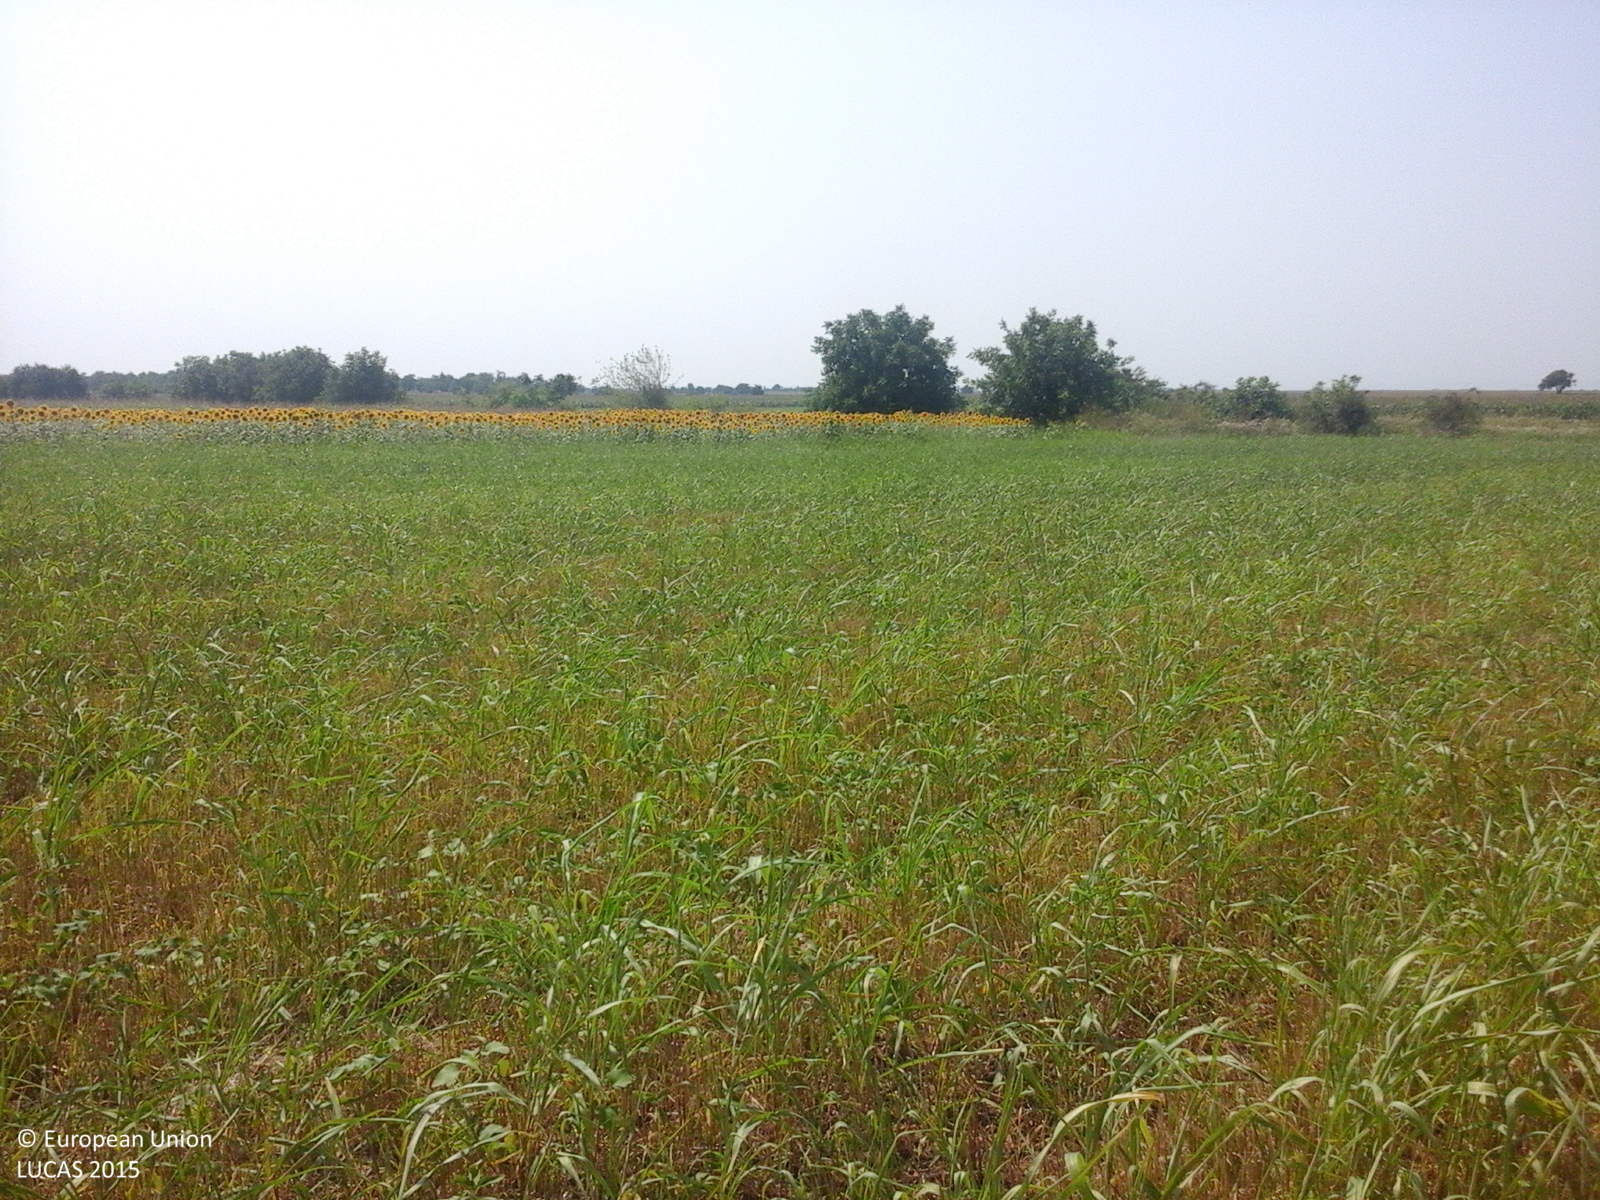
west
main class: Cropland
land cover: Barley
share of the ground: 25 - 50 %
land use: Agriculture (excluding fallow land and kitchen gardens)
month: July
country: RO
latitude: 44.8504
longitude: 26.7649
